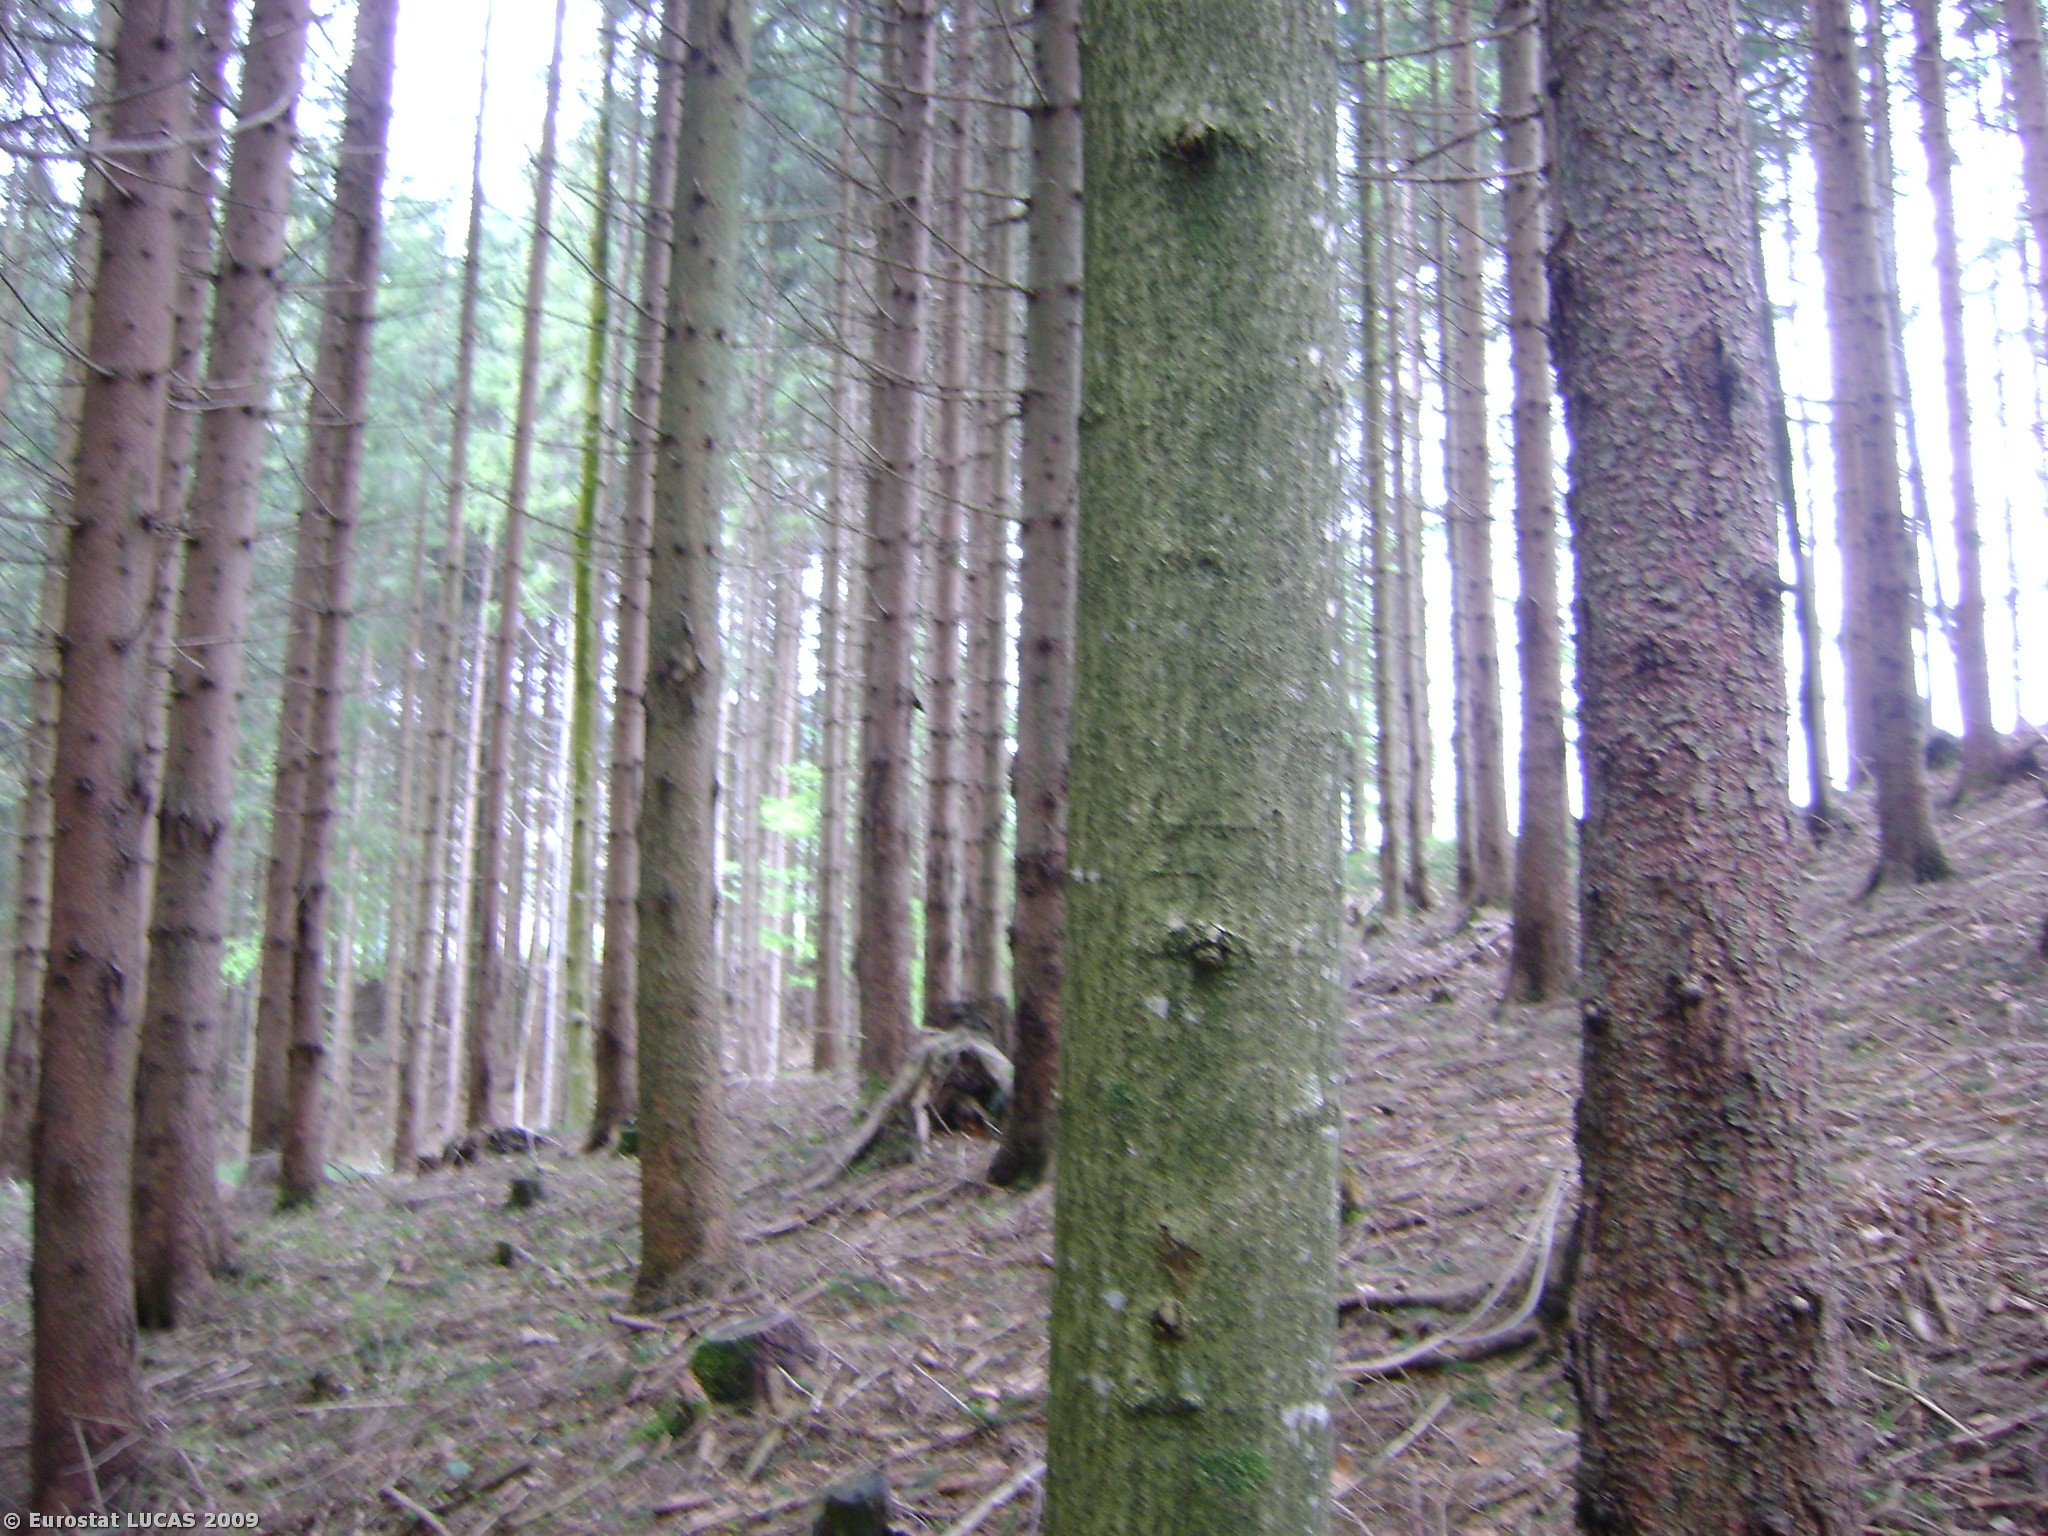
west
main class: Woodland
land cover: Mixed woodland
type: hemiboreal forest and nemoral coniferous forest and mixed broadleaved-coniferous forest
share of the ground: > 75 %
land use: Forestry
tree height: > 5 m
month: May
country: AT
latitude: 47.7805
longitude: 13.2151
